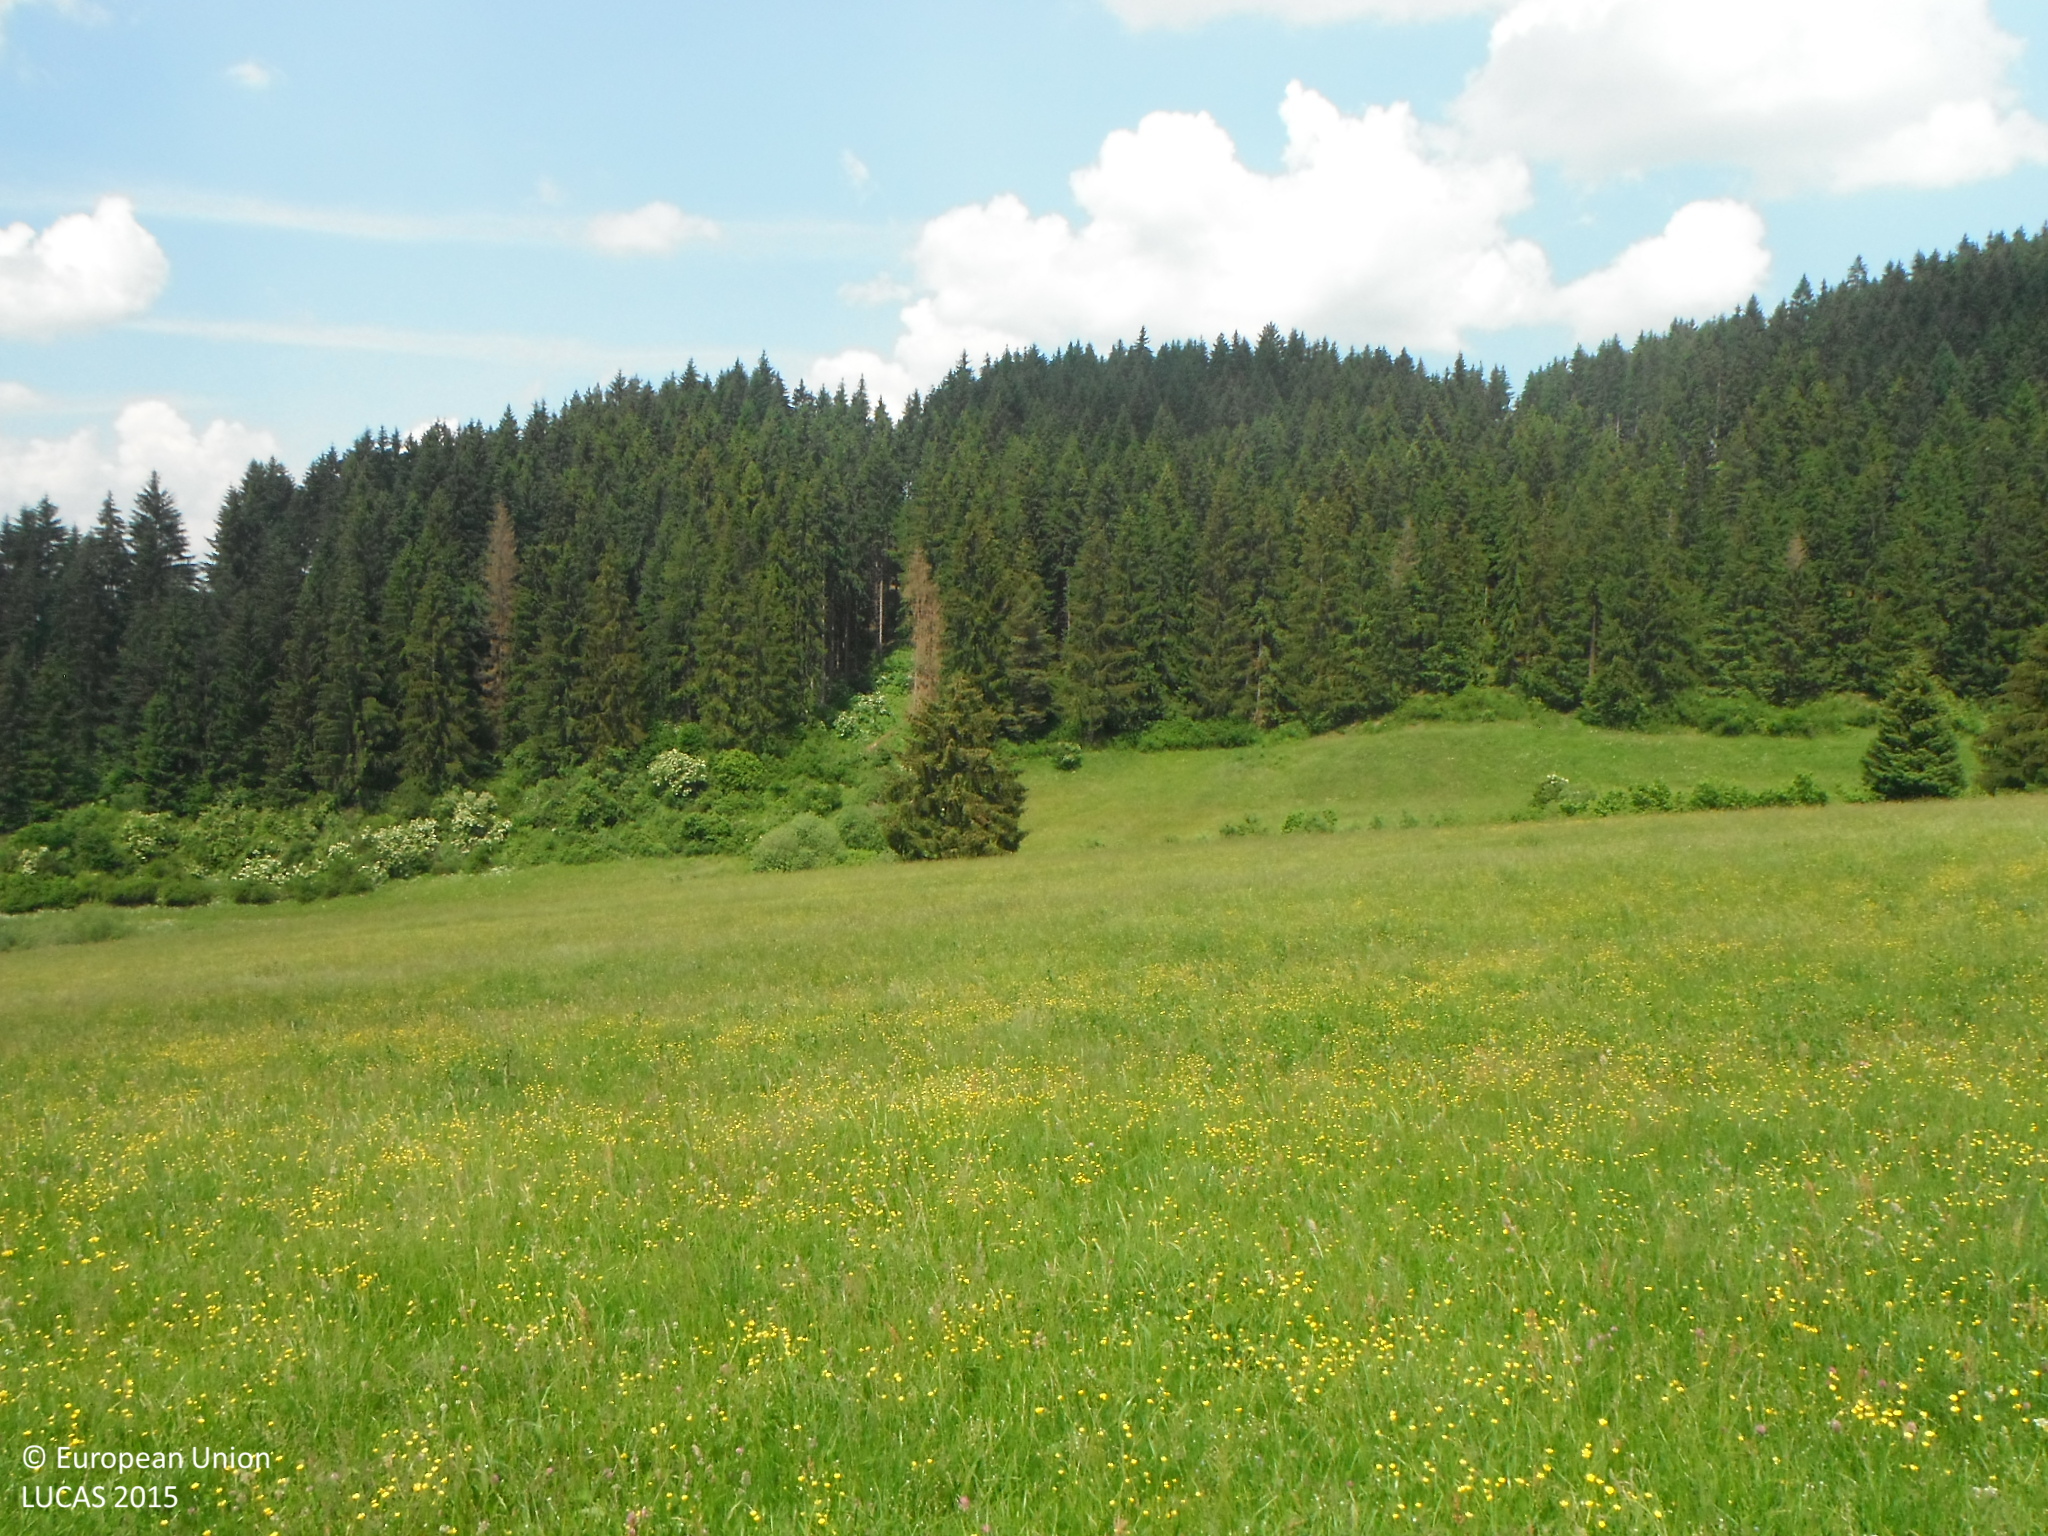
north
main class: Grassland
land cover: Grassland without tree/shrub cover
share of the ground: > 75 %
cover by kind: herbaceous plants 100 %
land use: Agriculture (excluding fallow land and kitchen gardens)
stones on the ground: < 10 %
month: June
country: SK
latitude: 49.0396
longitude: 19.3405
